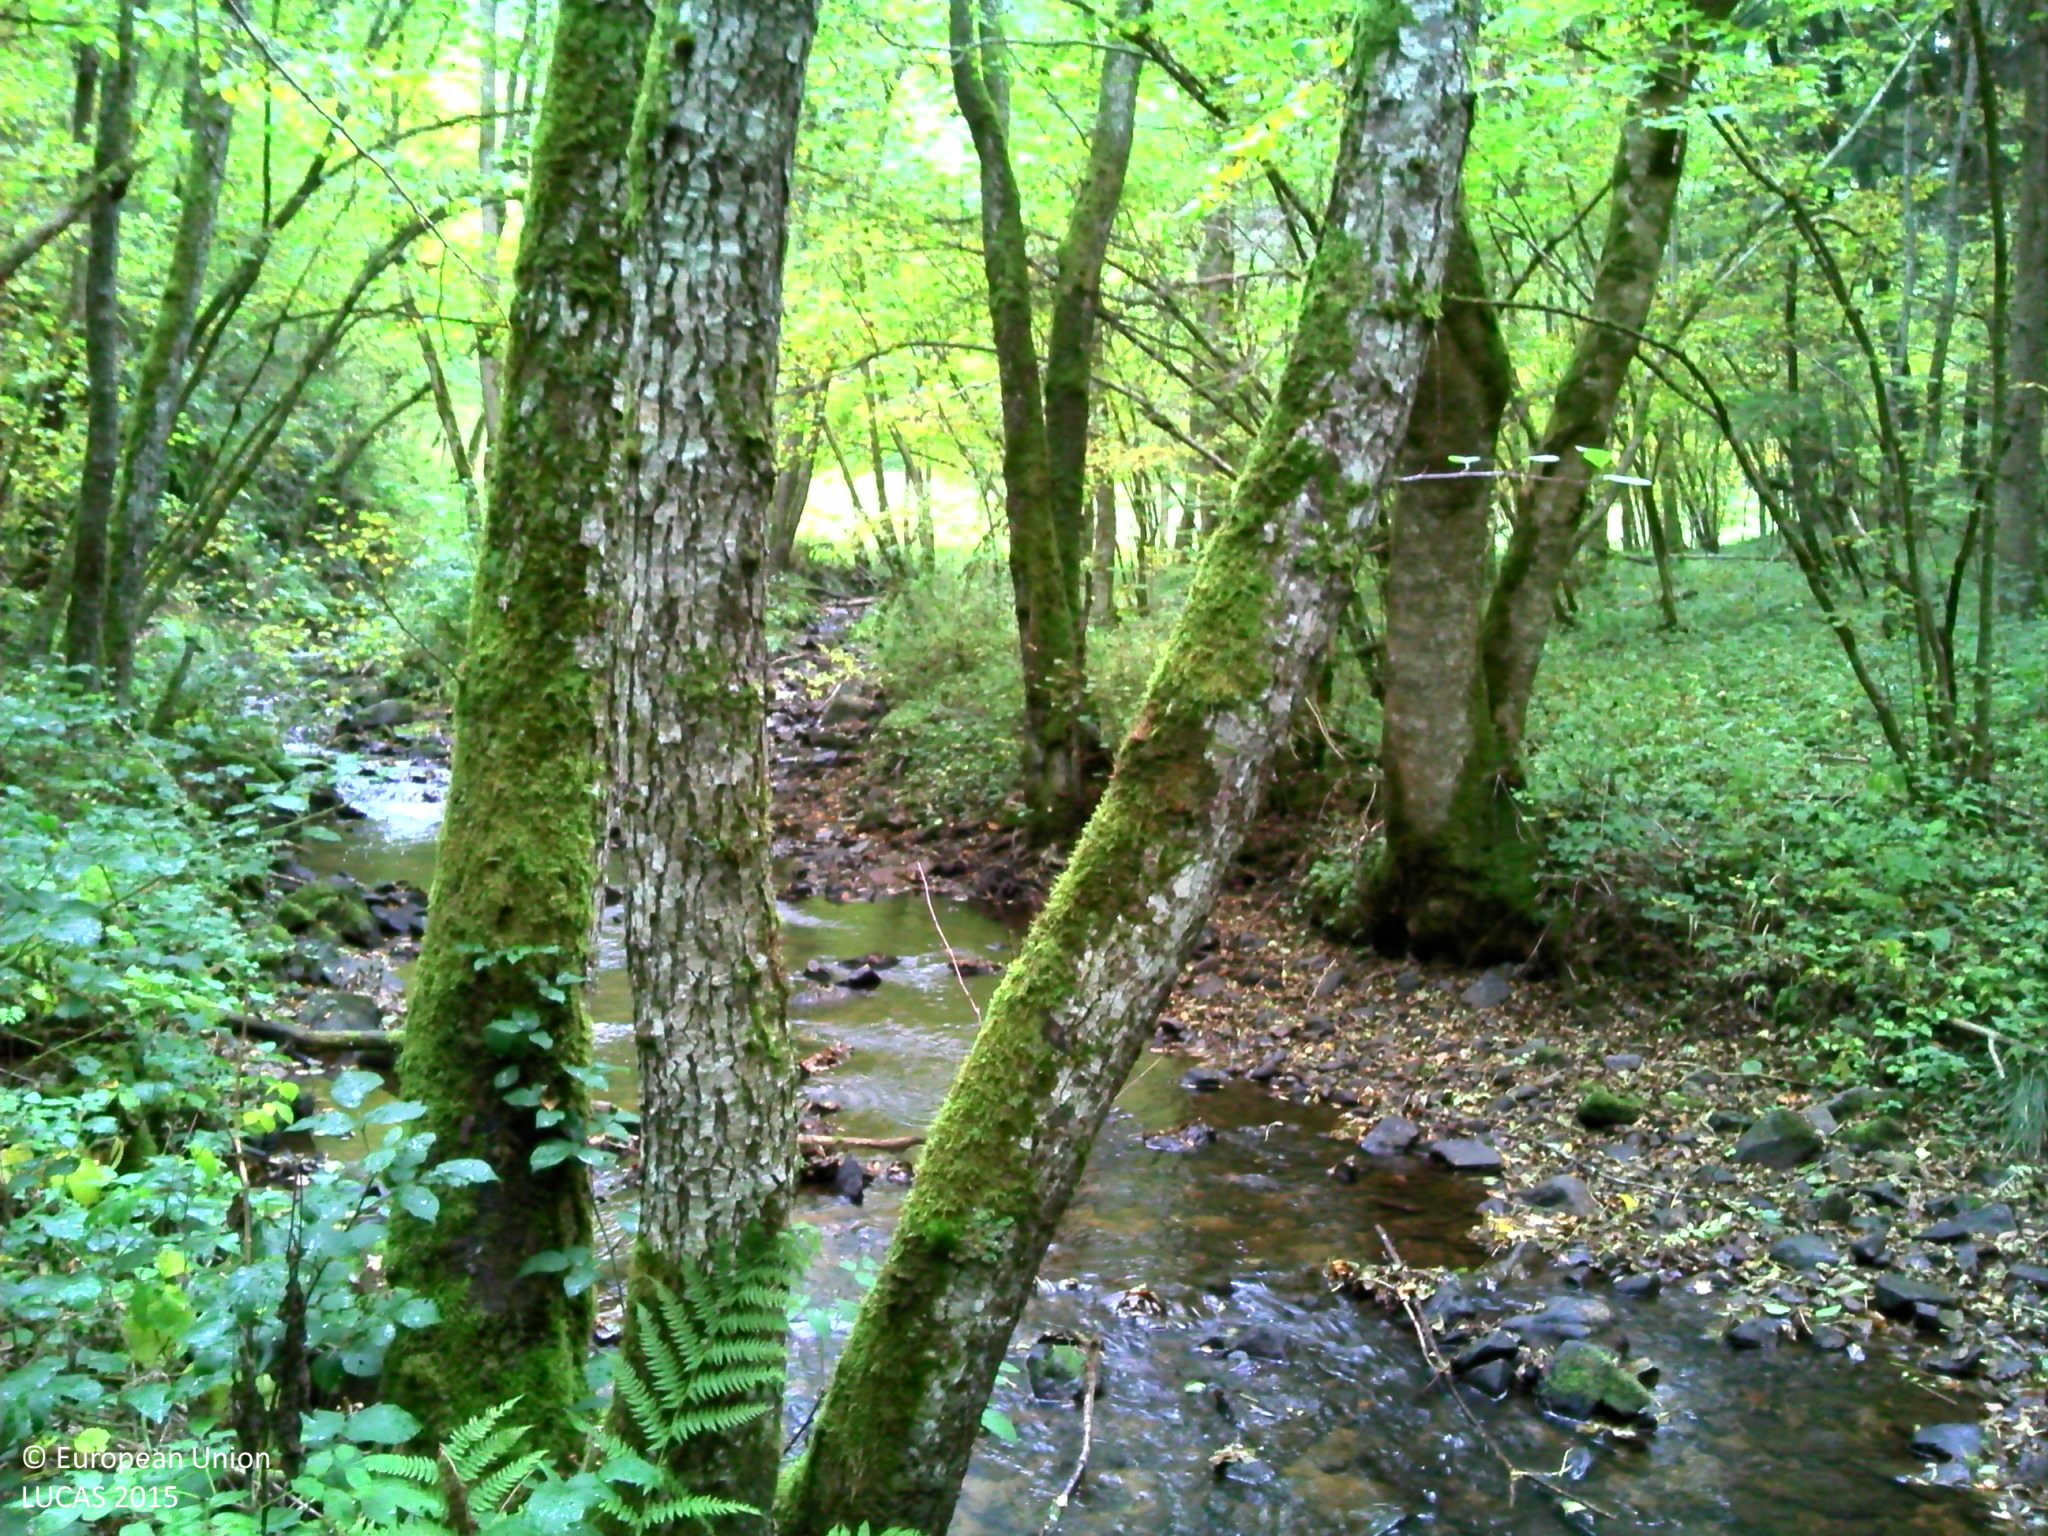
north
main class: Woodland
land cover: Broadleaved woodland
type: mesophytic deciduous forest
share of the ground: > 75 %
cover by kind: broadleaved forest trees 80 %, herbaceous plants 10 %, coniferous forest trees 5 %, shrubs 5 %
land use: Forestry
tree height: > 5 m
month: October
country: FR
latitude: 45.9986
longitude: 2.7800
